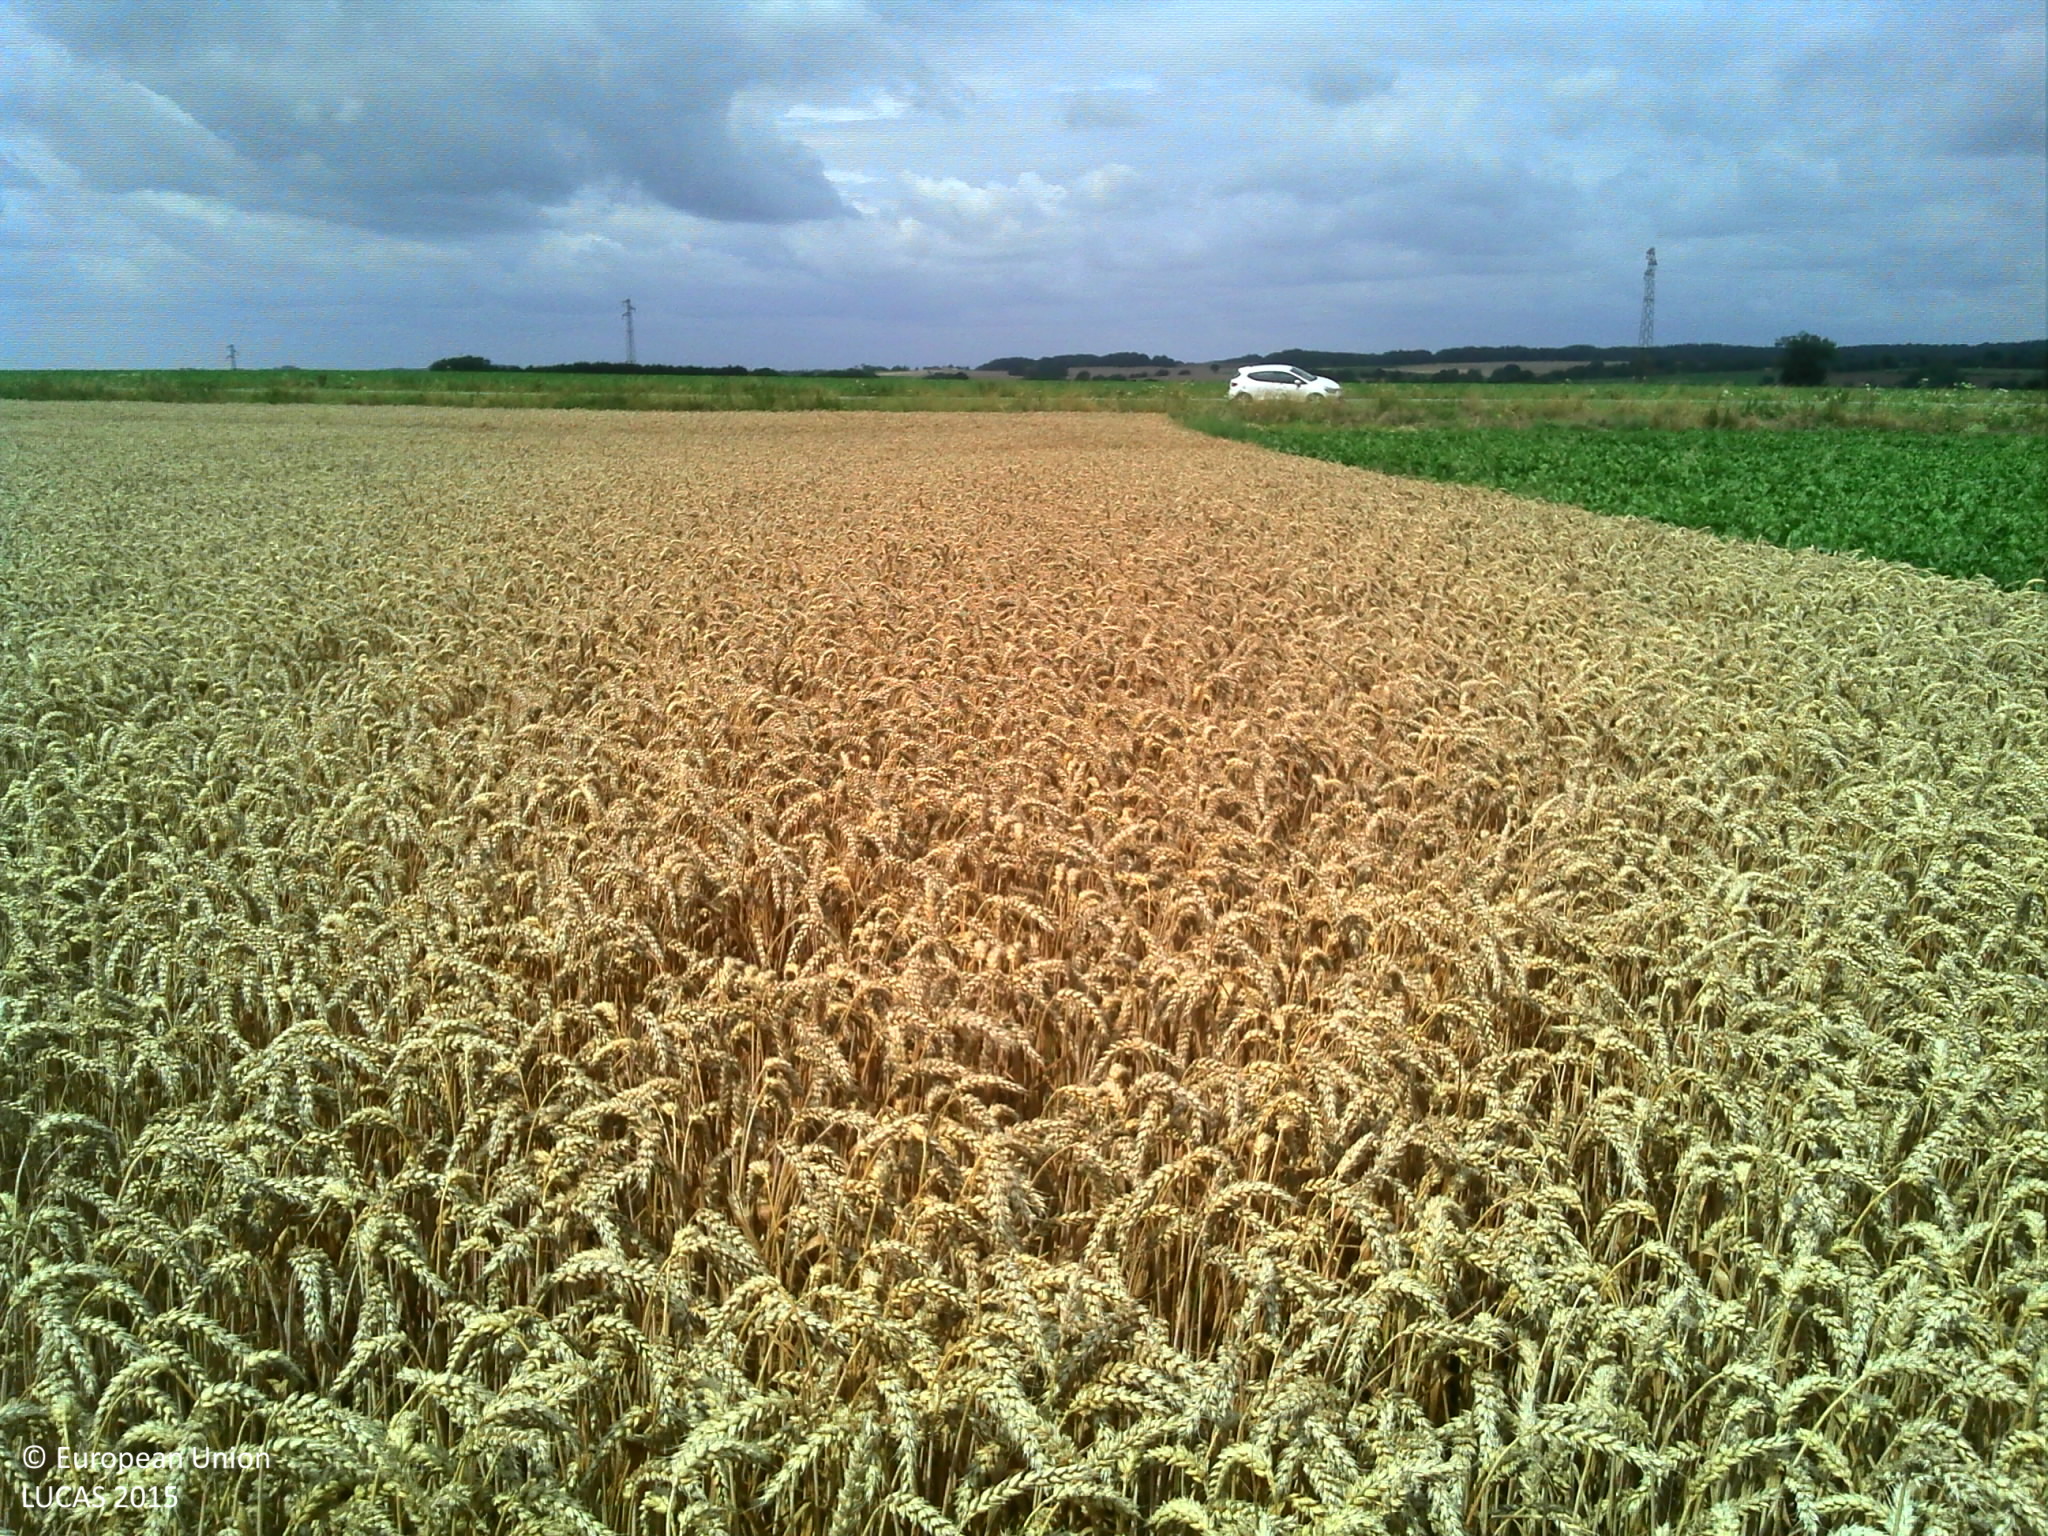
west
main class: Cropland
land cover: Common wheat
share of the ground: > 75 %
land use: Agriculture (excluding fallow land and kitchen gardens)
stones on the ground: < 10 %
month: July
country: FR
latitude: 49.9711
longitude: 3.6492
